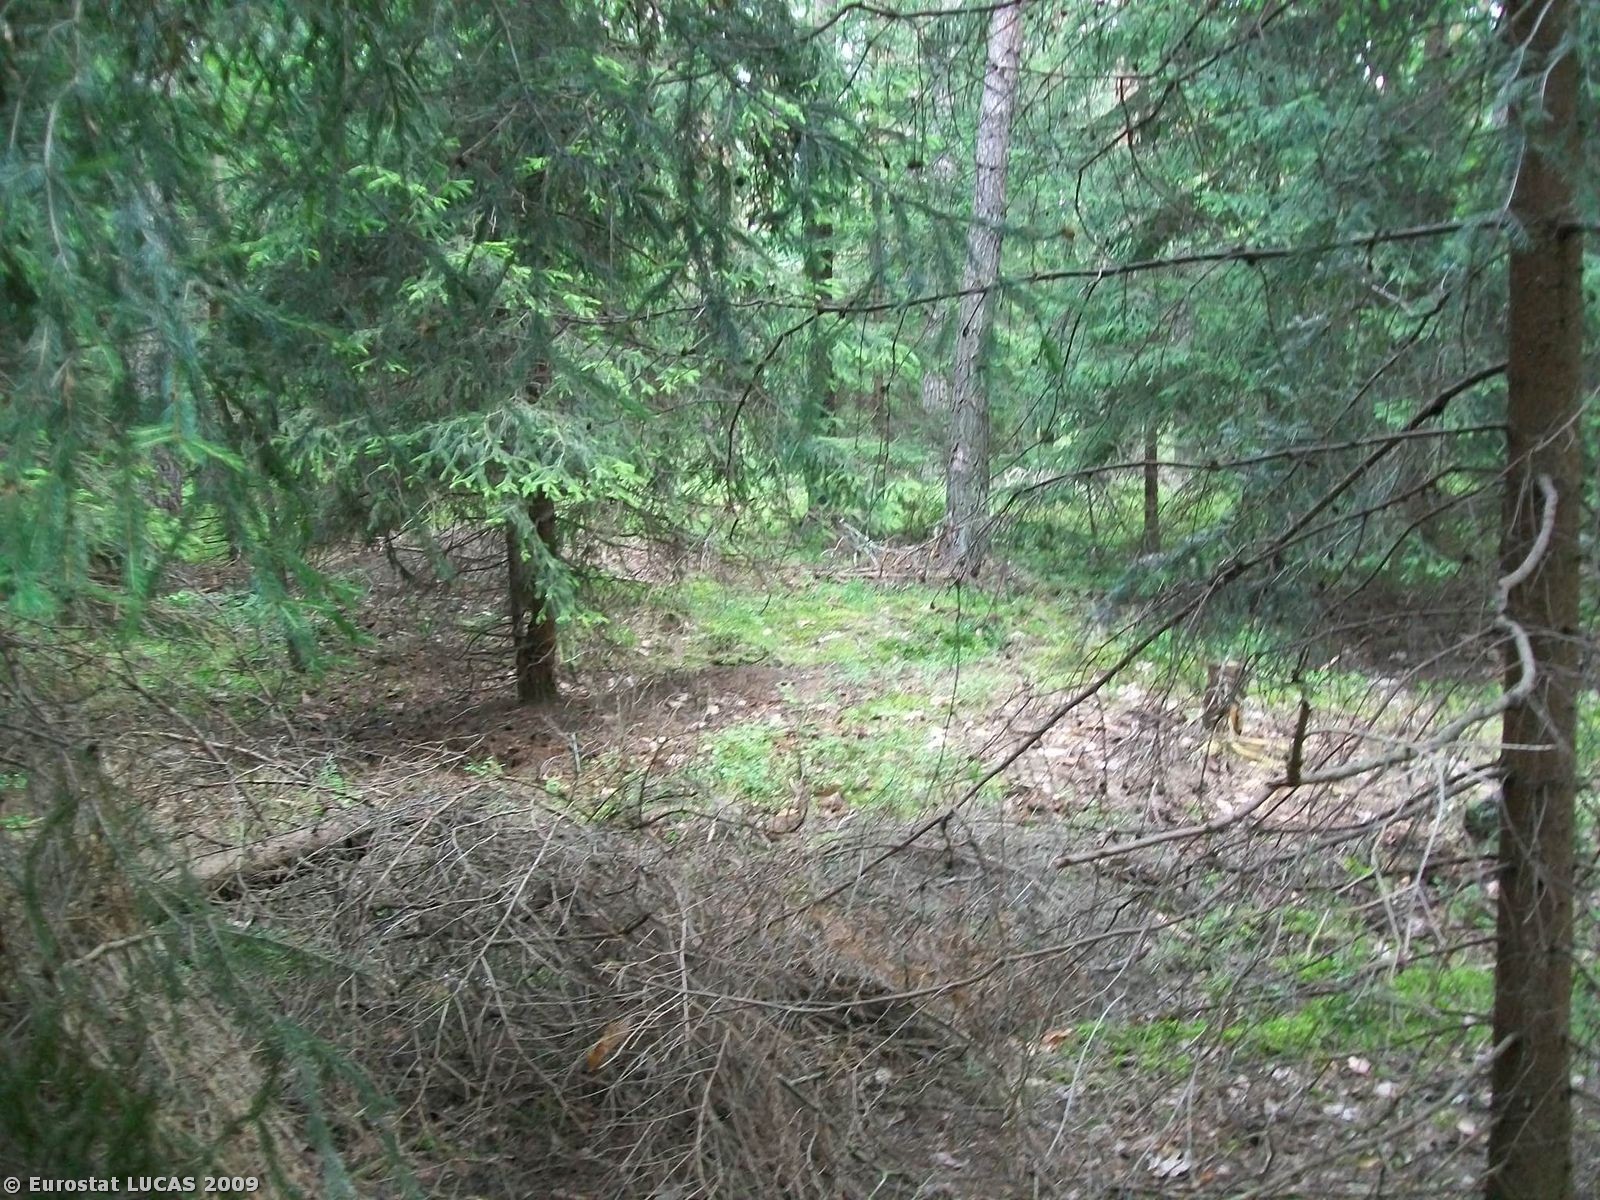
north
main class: Woodland
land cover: Mixed woodland
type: hemiboreal forest and nemoral coniferous forest and mixed broadleaved-coniferous forest
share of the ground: > 75 %
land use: Nature reserves
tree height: > 5 m
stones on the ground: < 10 %
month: July
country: PL
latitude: 51.2917
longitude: 15.1801
